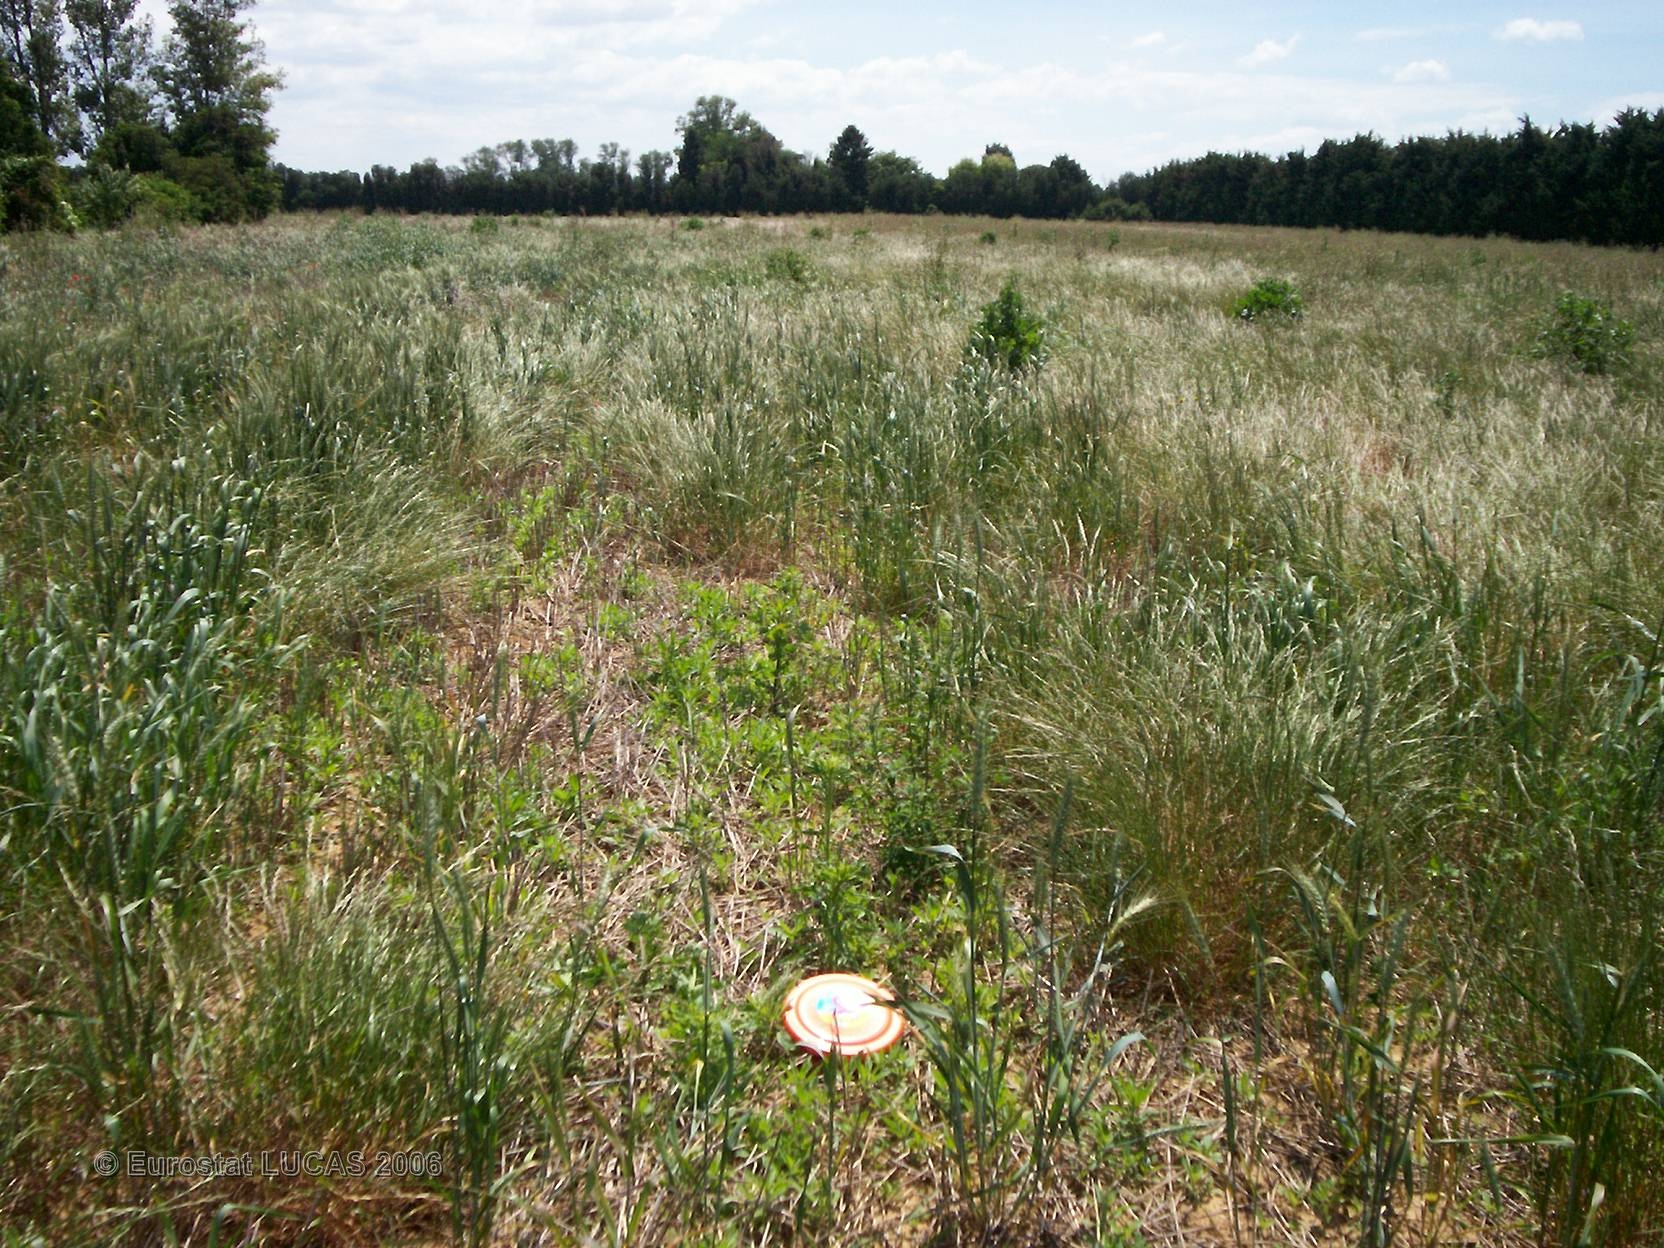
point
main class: Grassland
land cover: Grassland without tree/shrub cover
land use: Fallow land
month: June
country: FR
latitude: 44.8937
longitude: 4.9029
